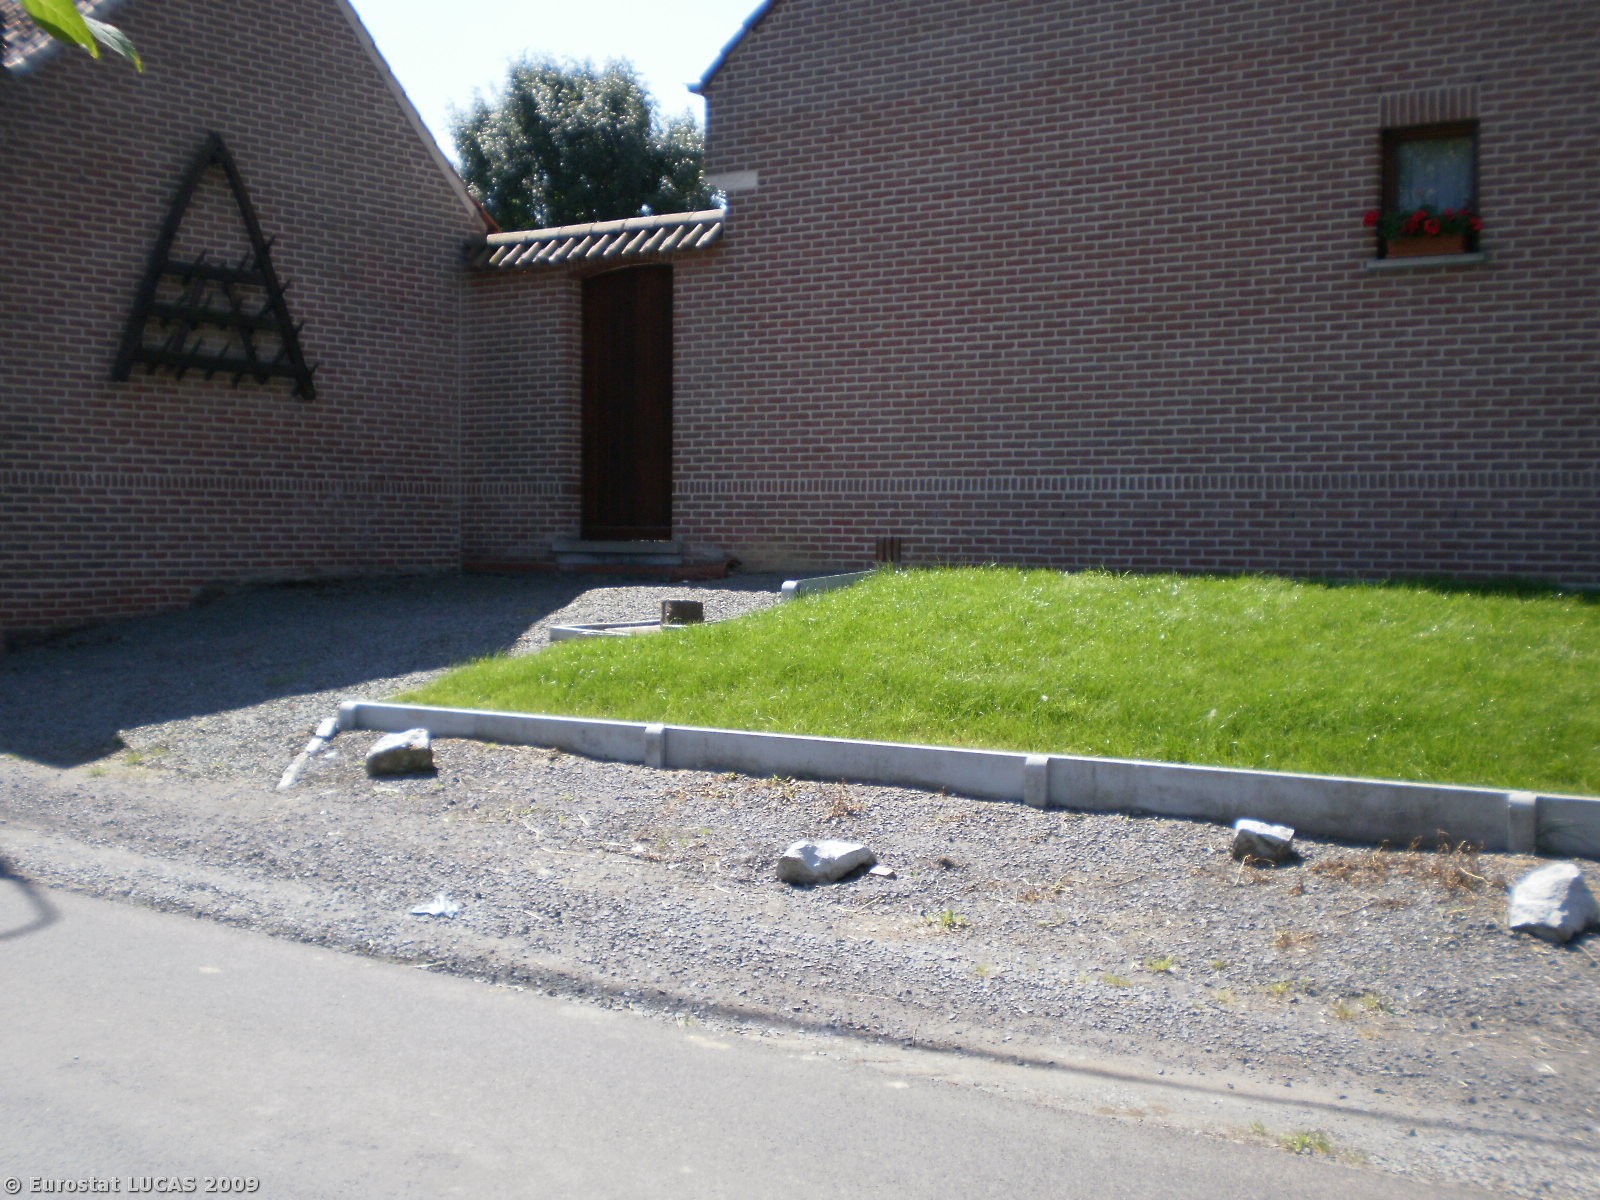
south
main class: Grassland
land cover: Grassland without tree/shrub cover
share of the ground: > 75 %
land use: Agriculture (excluding fallow land and kitchen gardens)
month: August
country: BE
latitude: 50.8429
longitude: 3.7587
